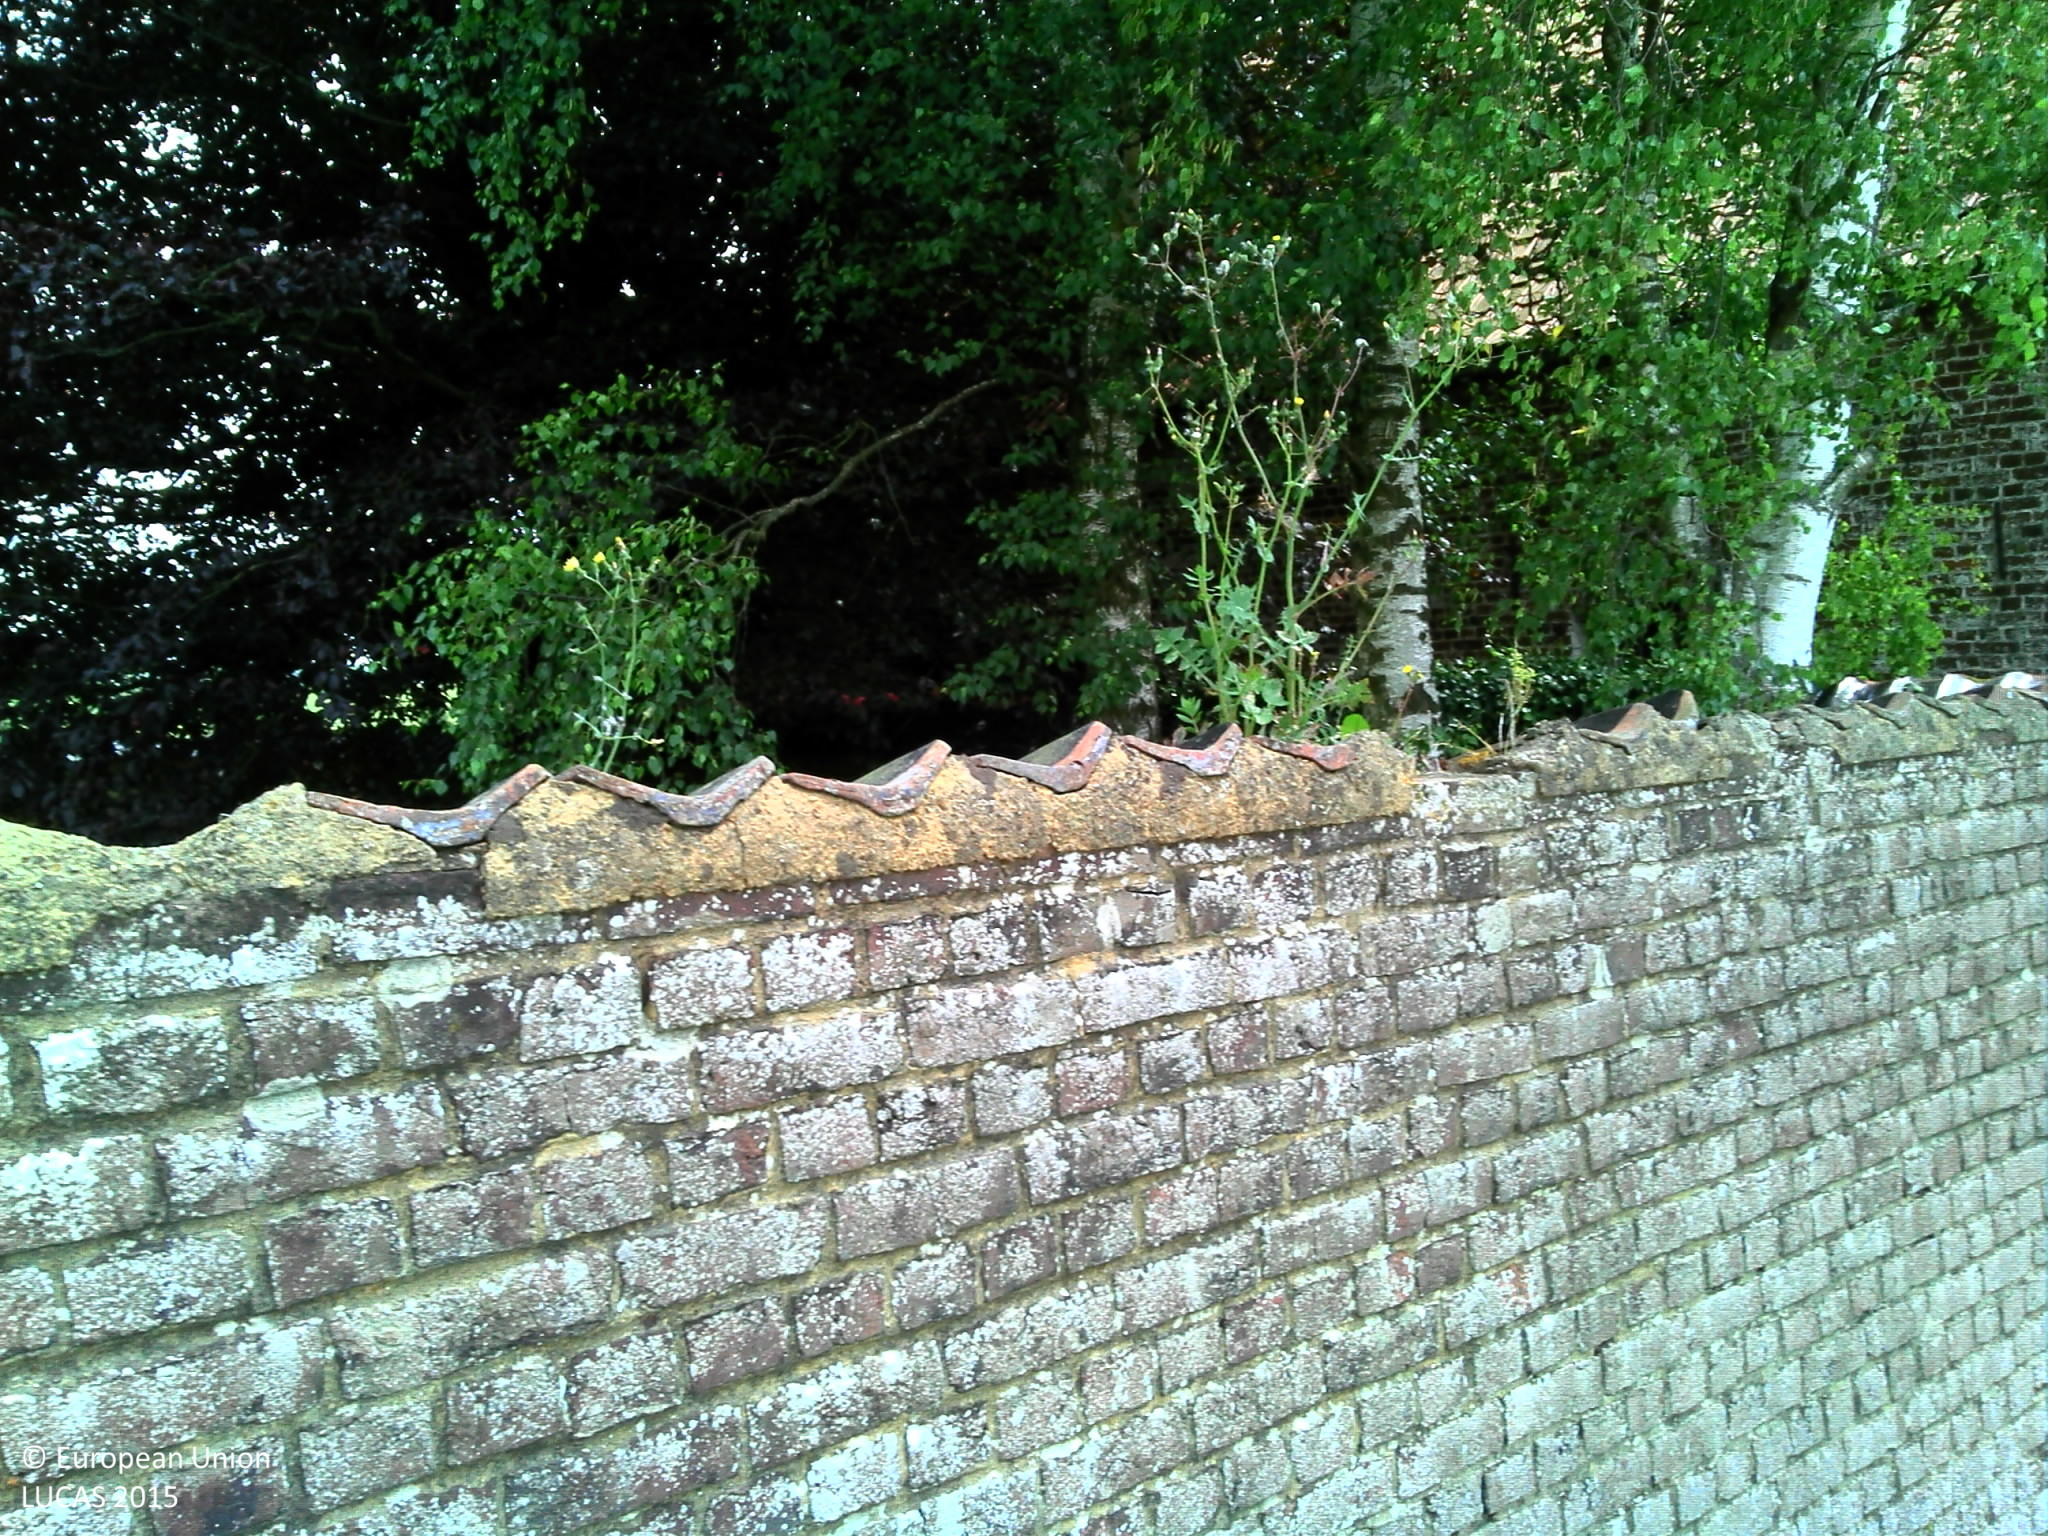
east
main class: Grassland
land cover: Grassland without tree/shrub cover
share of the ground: > 75 %
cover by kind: herbaceous plants 100 %
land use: Amenities, museums, leisure
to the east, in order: Grassland without tree/shrub cover; Artificial constructions; Grassland without tree/shrub cover; Maize; Tracks; Grass margins; Broadleaved woodland; Grass margins; Grassland without tree/shrub cover; Electric lines; Grassland without tree/shrub cover
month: June
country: BE
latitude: 50.6429
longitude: 3.7286
